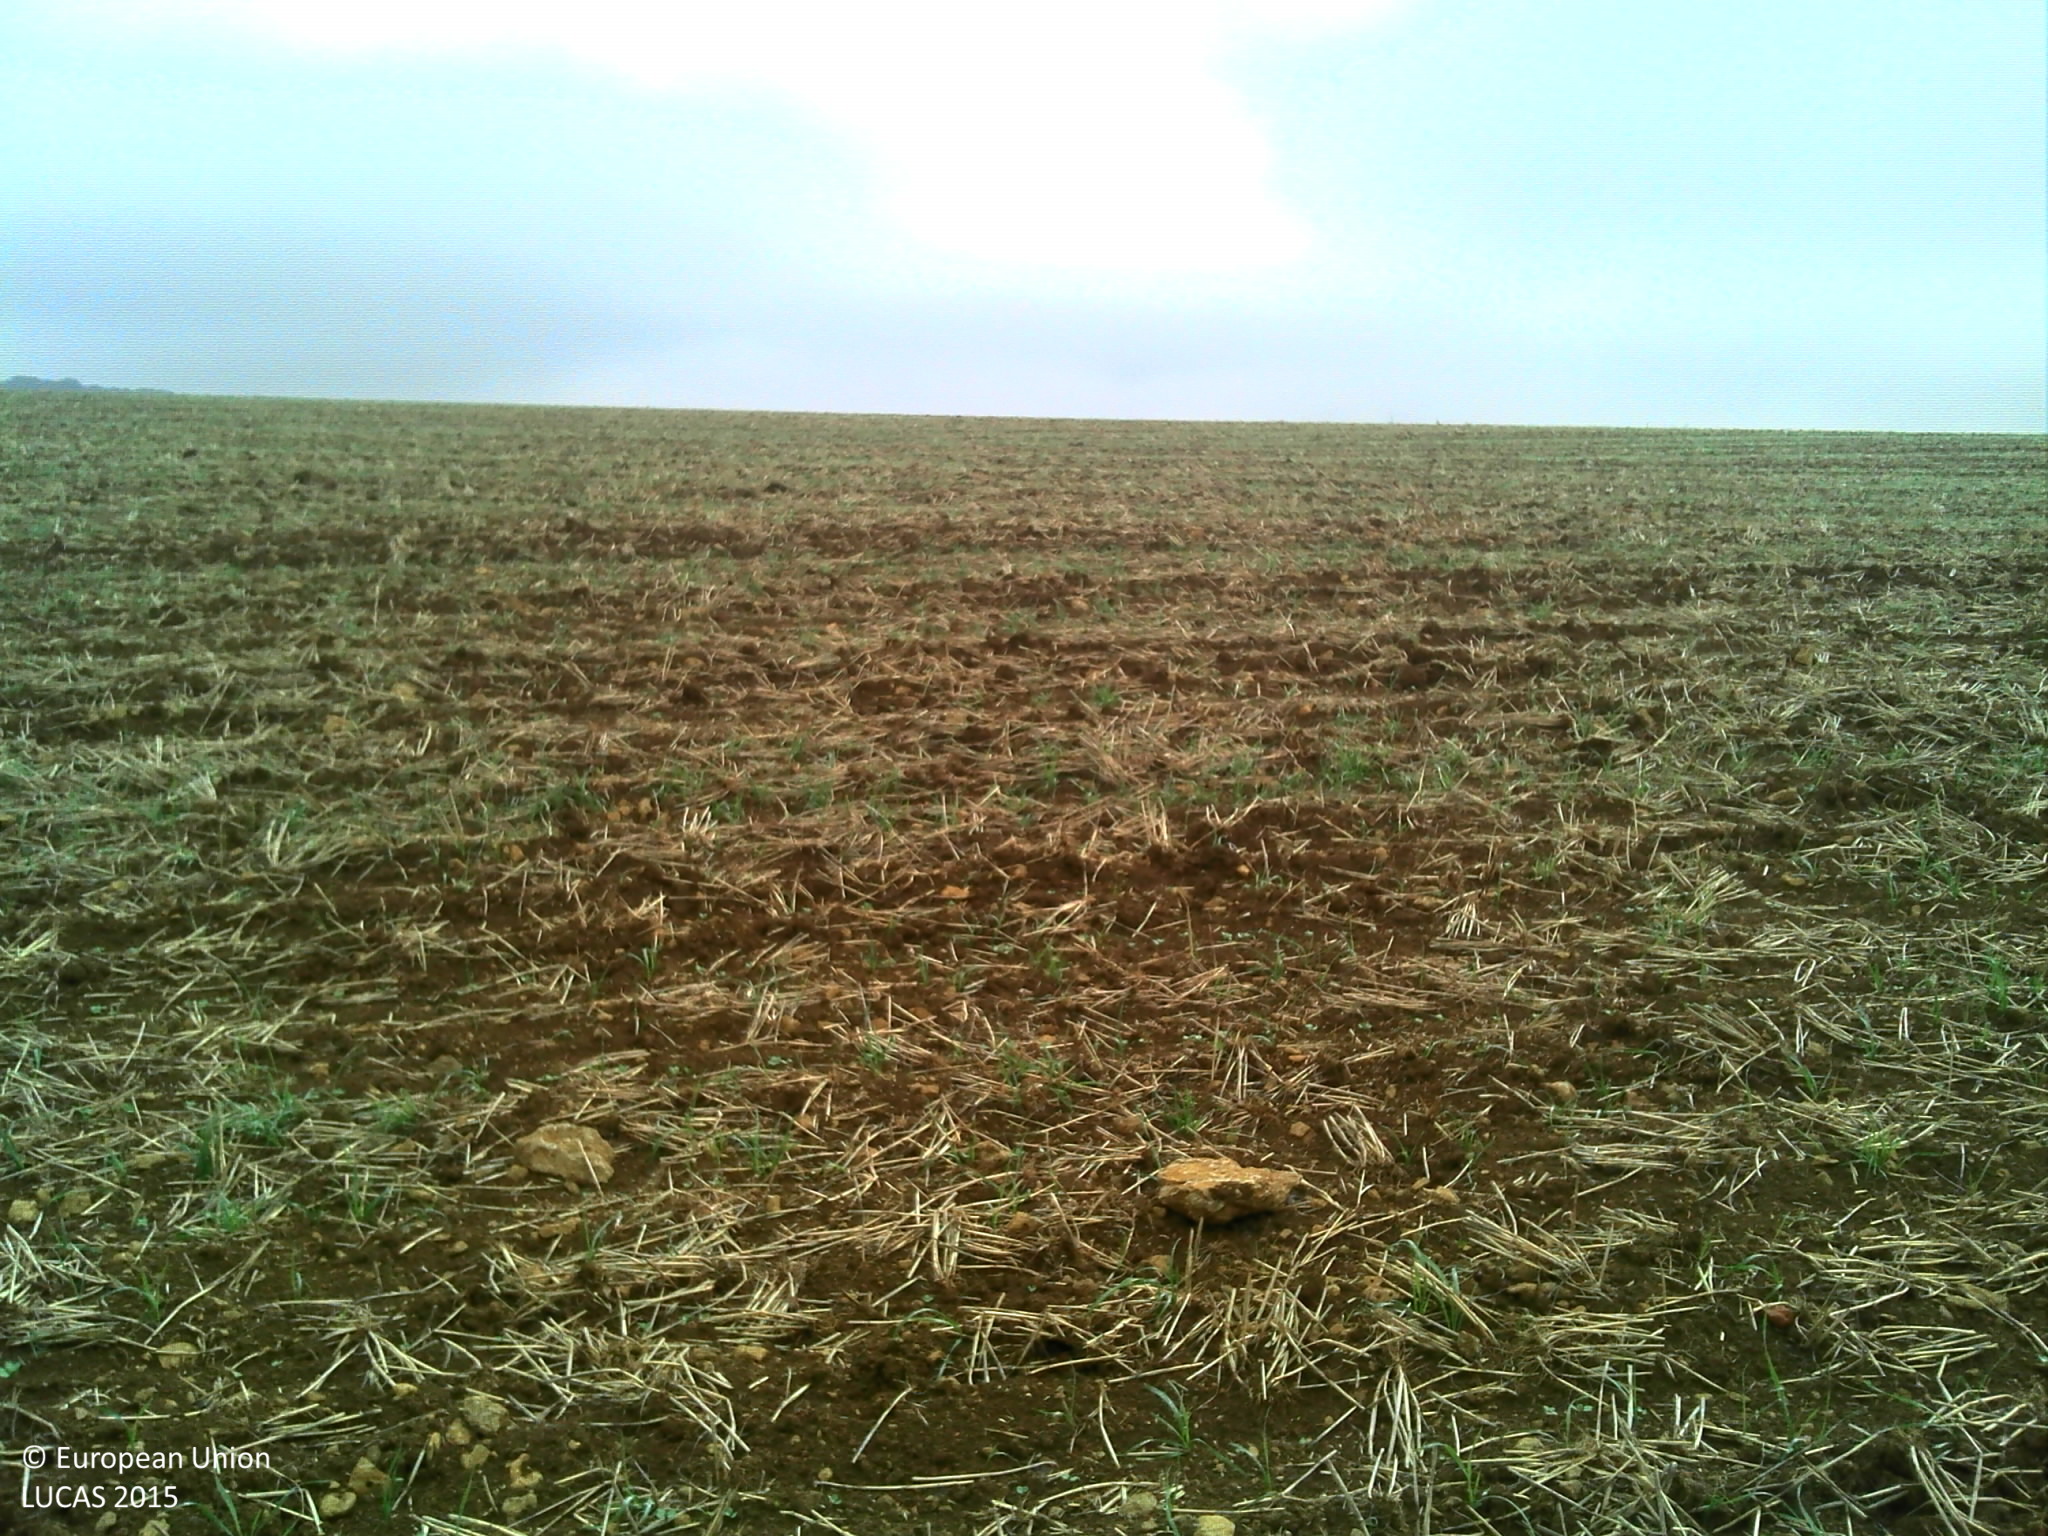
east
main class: Cropland
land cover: Other fibre and oleaginous crops
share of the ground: < 10 %
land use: Agriculture (excluding fallow land and kitchen gardens)
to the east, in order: Other fibre and oleaginous crops; Common wheat
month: September
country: FR
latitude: 49.1751
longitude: 5.9254
